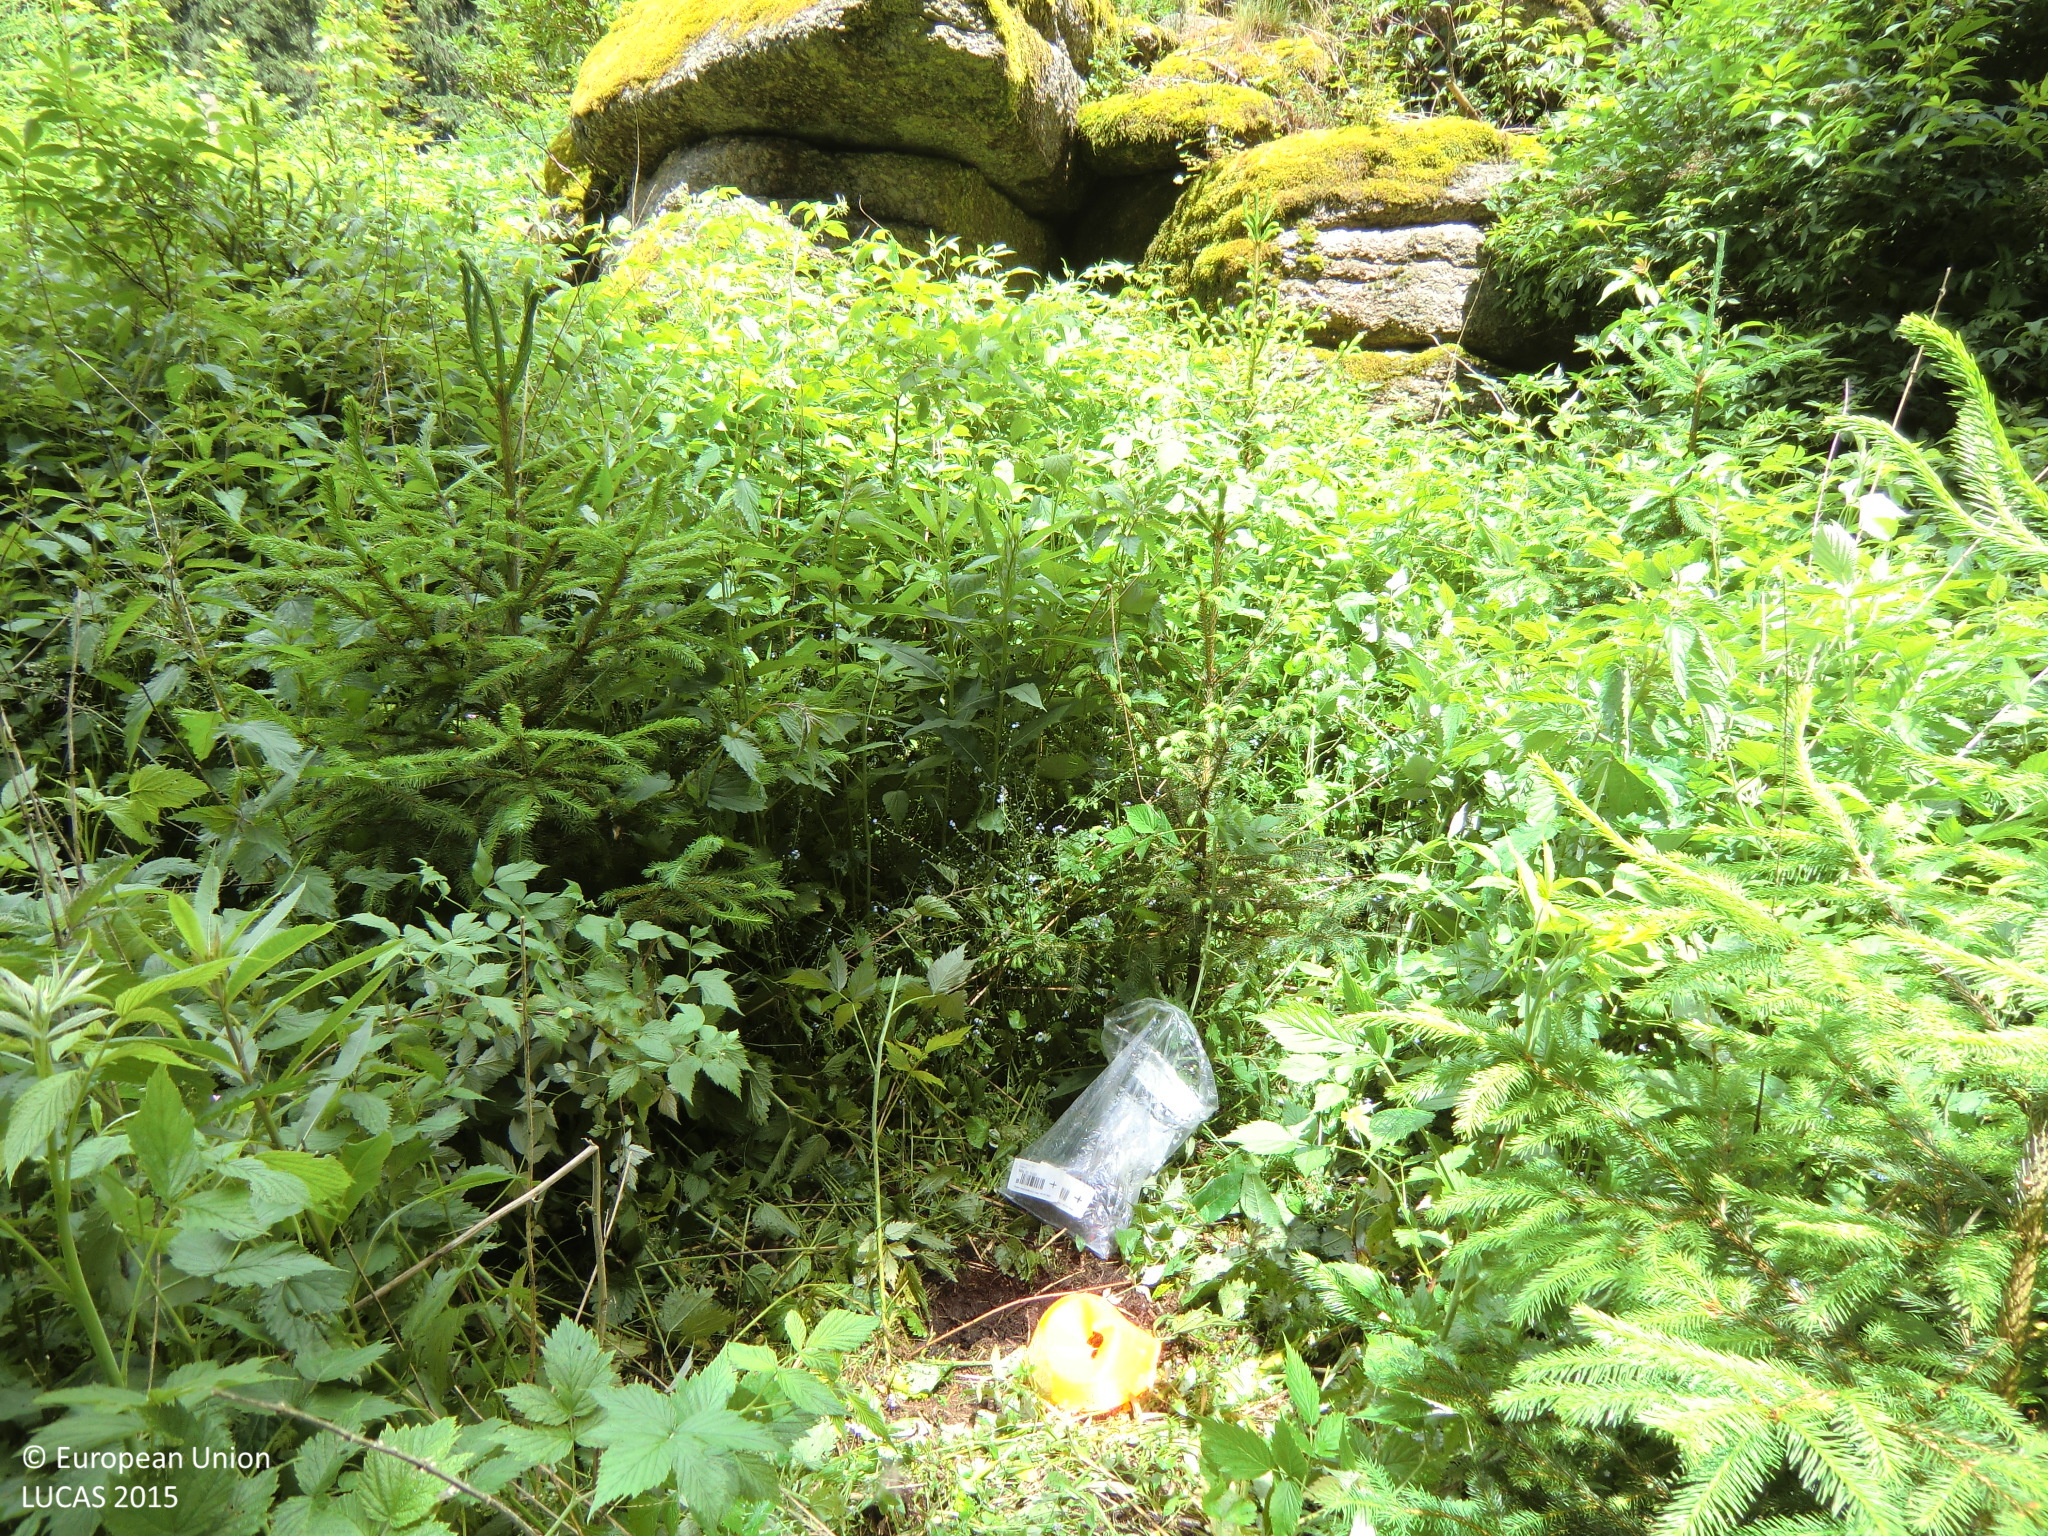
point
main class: Shrubland
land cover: Shrubland with sparse tree cover
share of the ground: > 75 %
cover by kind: shrubs 90 %, coniferous forest trees 5 %, herbaceous plants 5 %
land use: Forestry
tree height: < 5 m
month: June
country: AT
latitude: 48.5772
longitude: 14.6230
